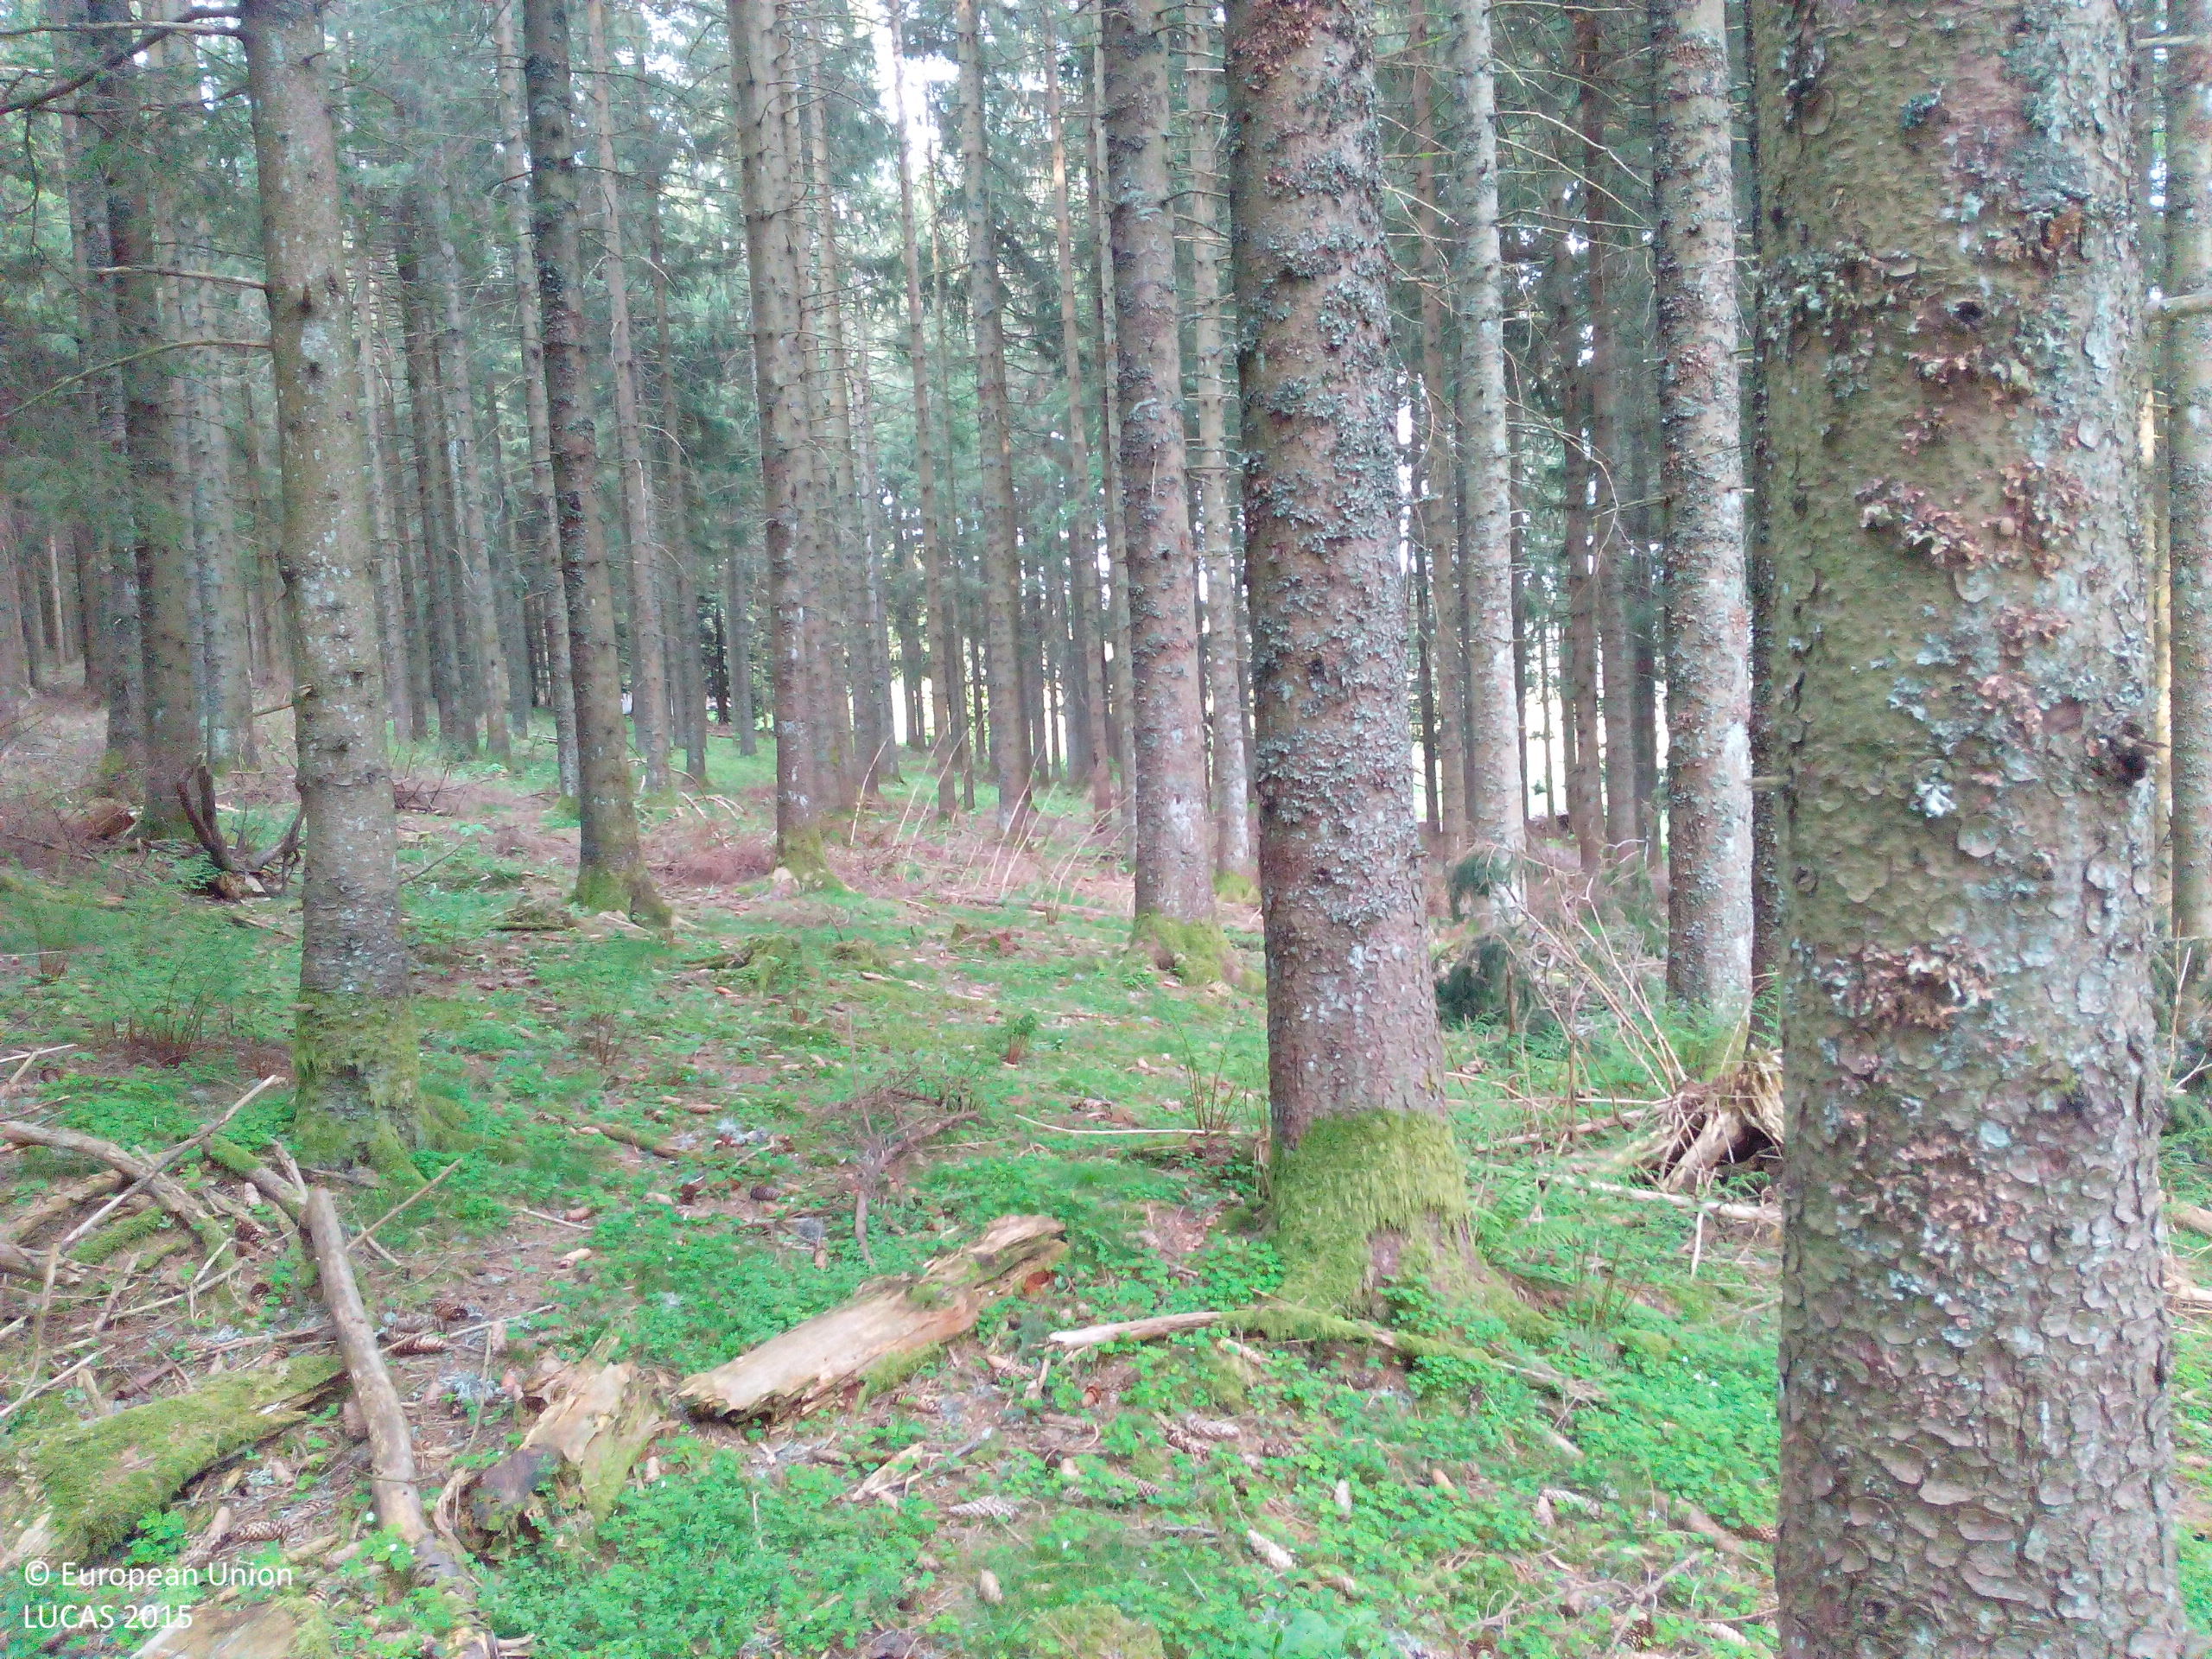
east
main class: Woodland
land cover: Spruce dominated coniferous woodland
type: hemiboreal forest and nemoral coniferous forest and mixed broadleaved-coniferous forest
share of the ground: > 75 %
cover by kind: coniferous forest trees 95 %, herbaceous plants 5 %
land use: Forestry
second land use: Amenities, museums, leisure
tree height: > 5 m
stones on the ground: < 10 %
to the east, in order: Spruce dominated coniferous woodland; Tracks; Grassland without tree/shrub cover
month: May
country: DE
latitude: 48.1007
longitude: 8.1881
